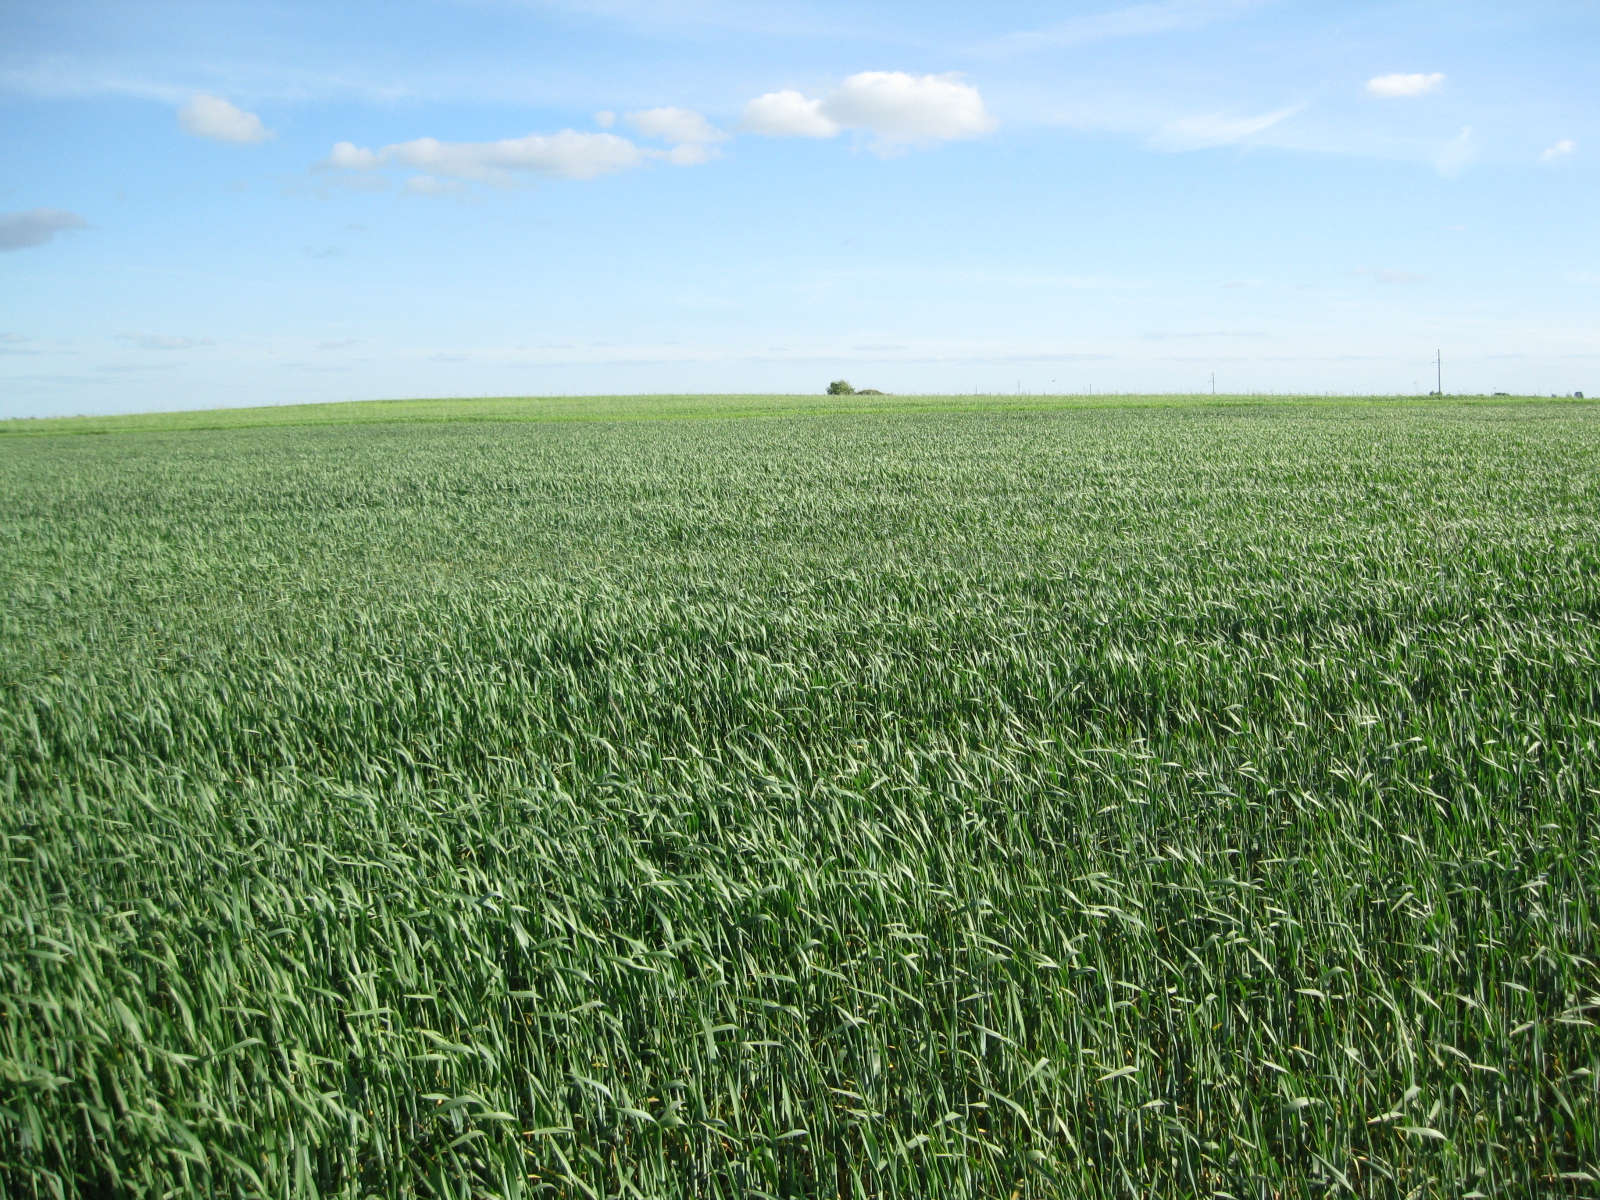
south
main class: Cropland
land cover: Common wheat
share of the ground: > 75 %
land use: Agriculture (excluding fallow land and kitchen gardens)
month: June
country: LT
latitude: 55.5394
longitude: 23.5332
